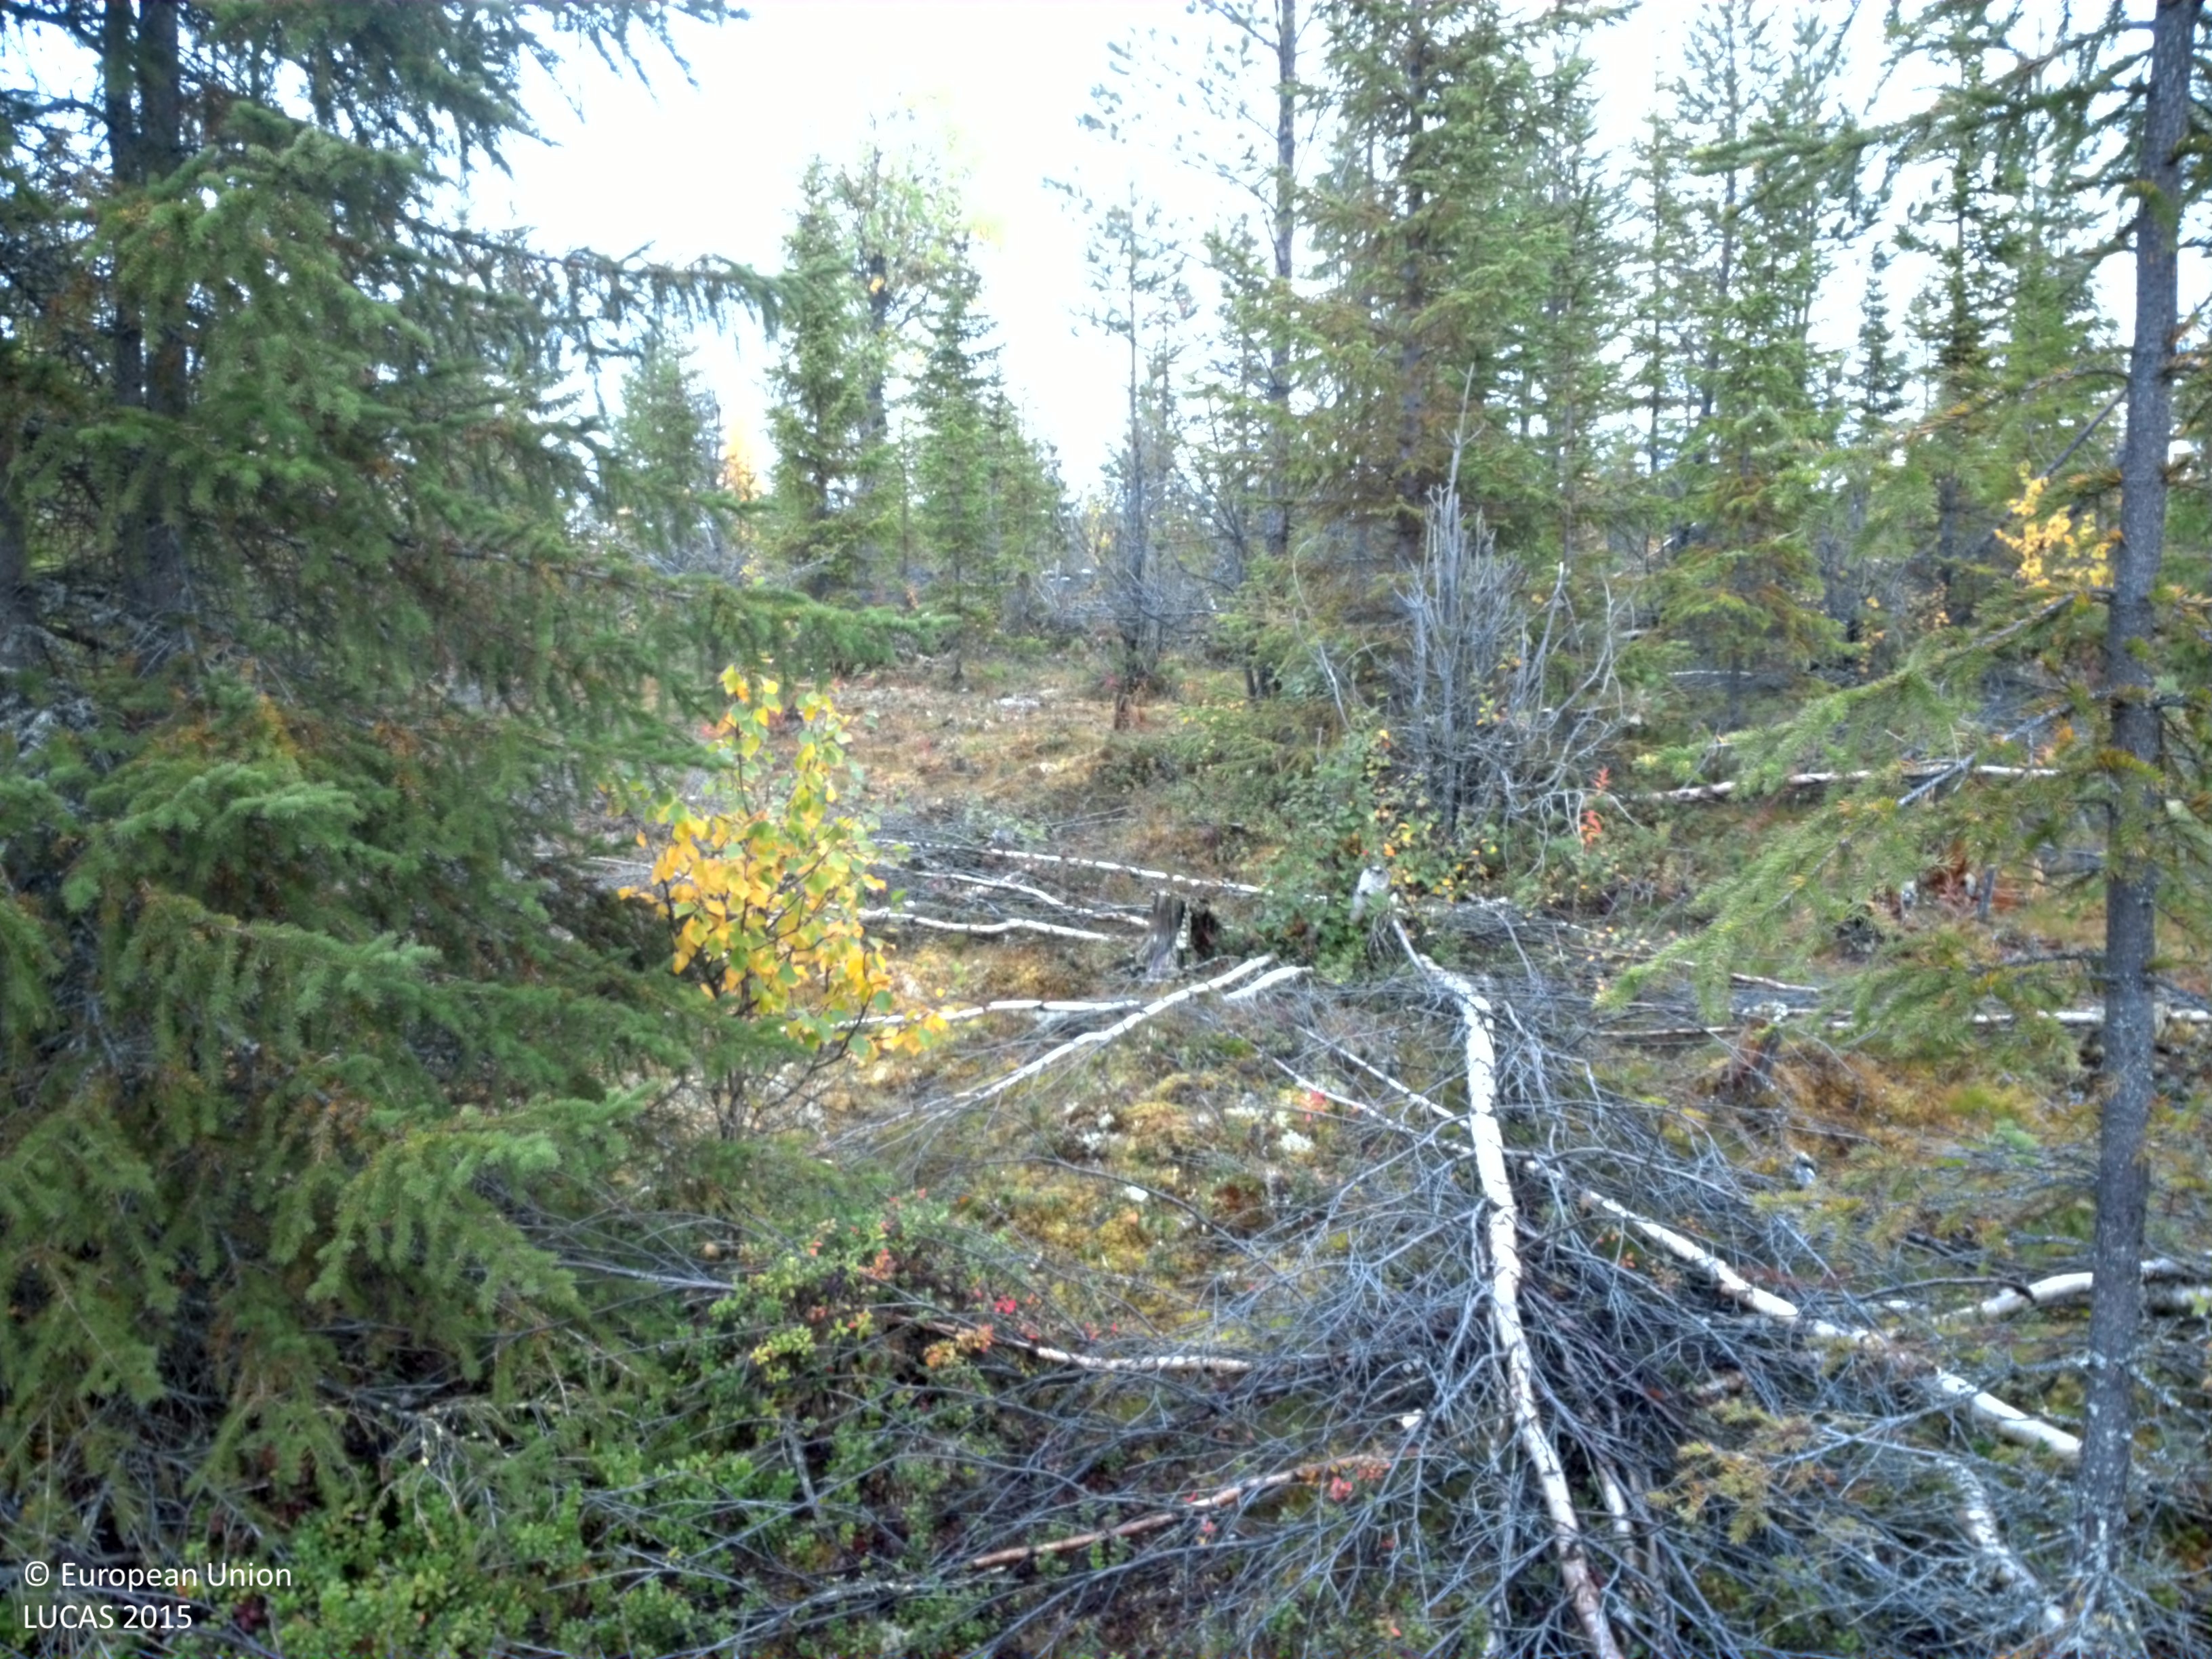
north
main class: Woodland
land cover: Spruce dominated coniferous woodland
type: boreal forest
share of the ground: 10 - 25 %
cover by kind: shrubs 40 %, lichens and mosses 20 %, herbaceous plants 15 %, coniferous forest trees 10 %
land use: Forestry
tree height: > 5 m
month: September
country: SE
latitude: 65.4030
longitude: 16.1425
